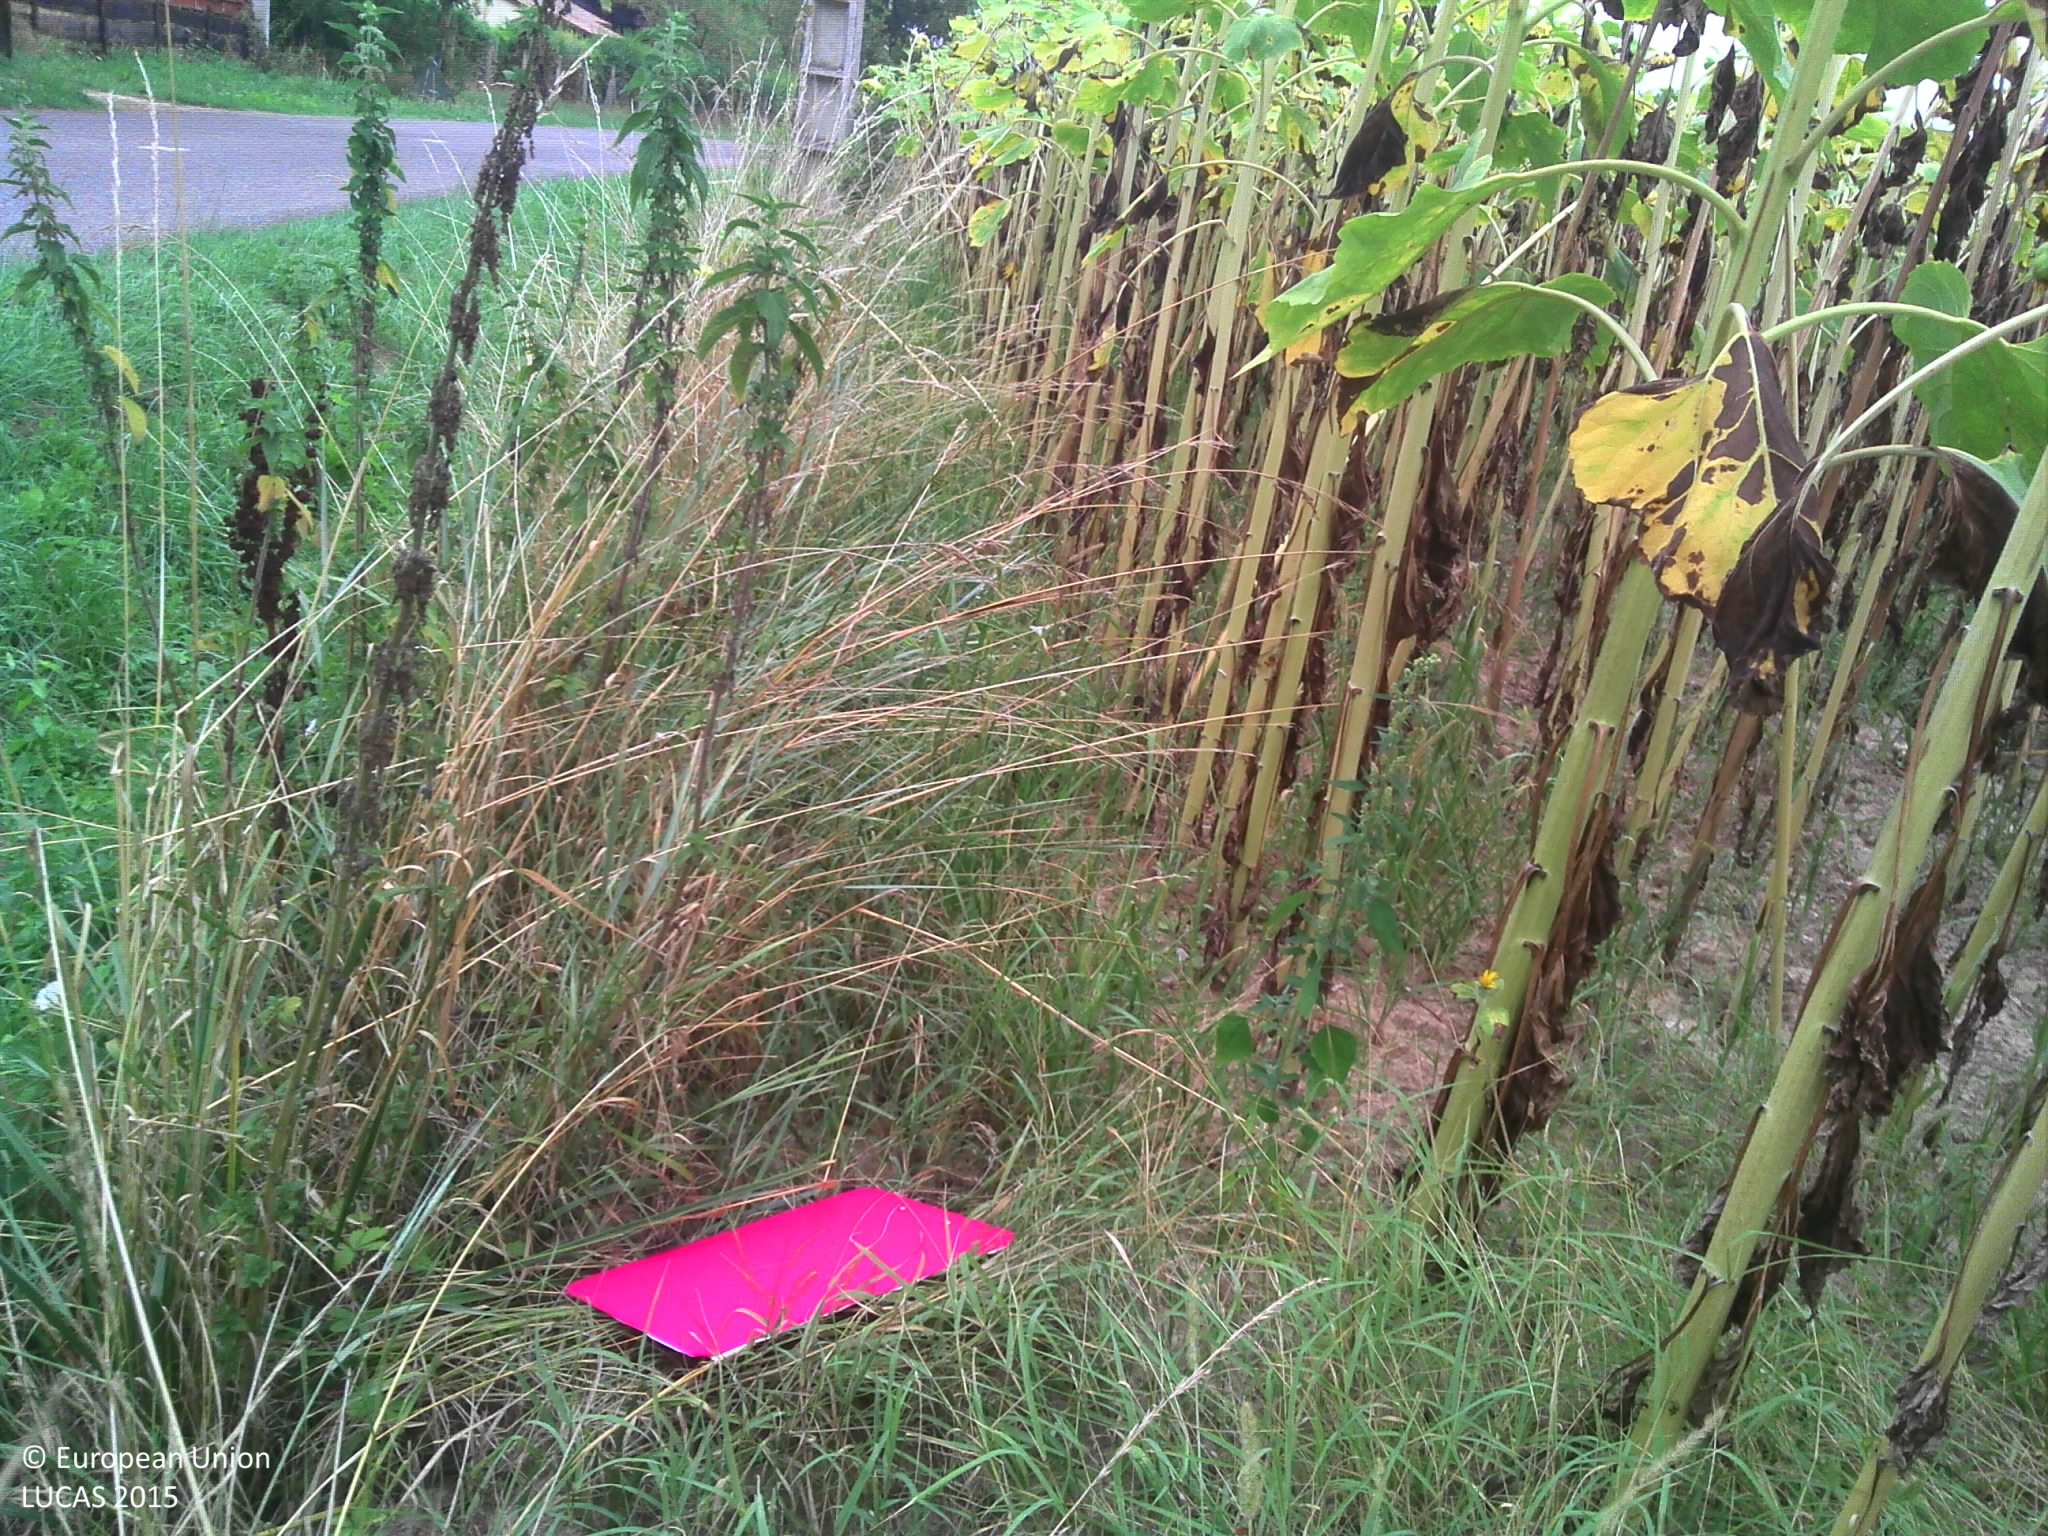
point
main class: Cropland
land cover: Sunflower
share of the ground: > 75 %
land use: Agriculture (excluding fallow land and kitchen gardens)
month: August
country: FR
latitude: 44.0707
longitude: 1.2466
